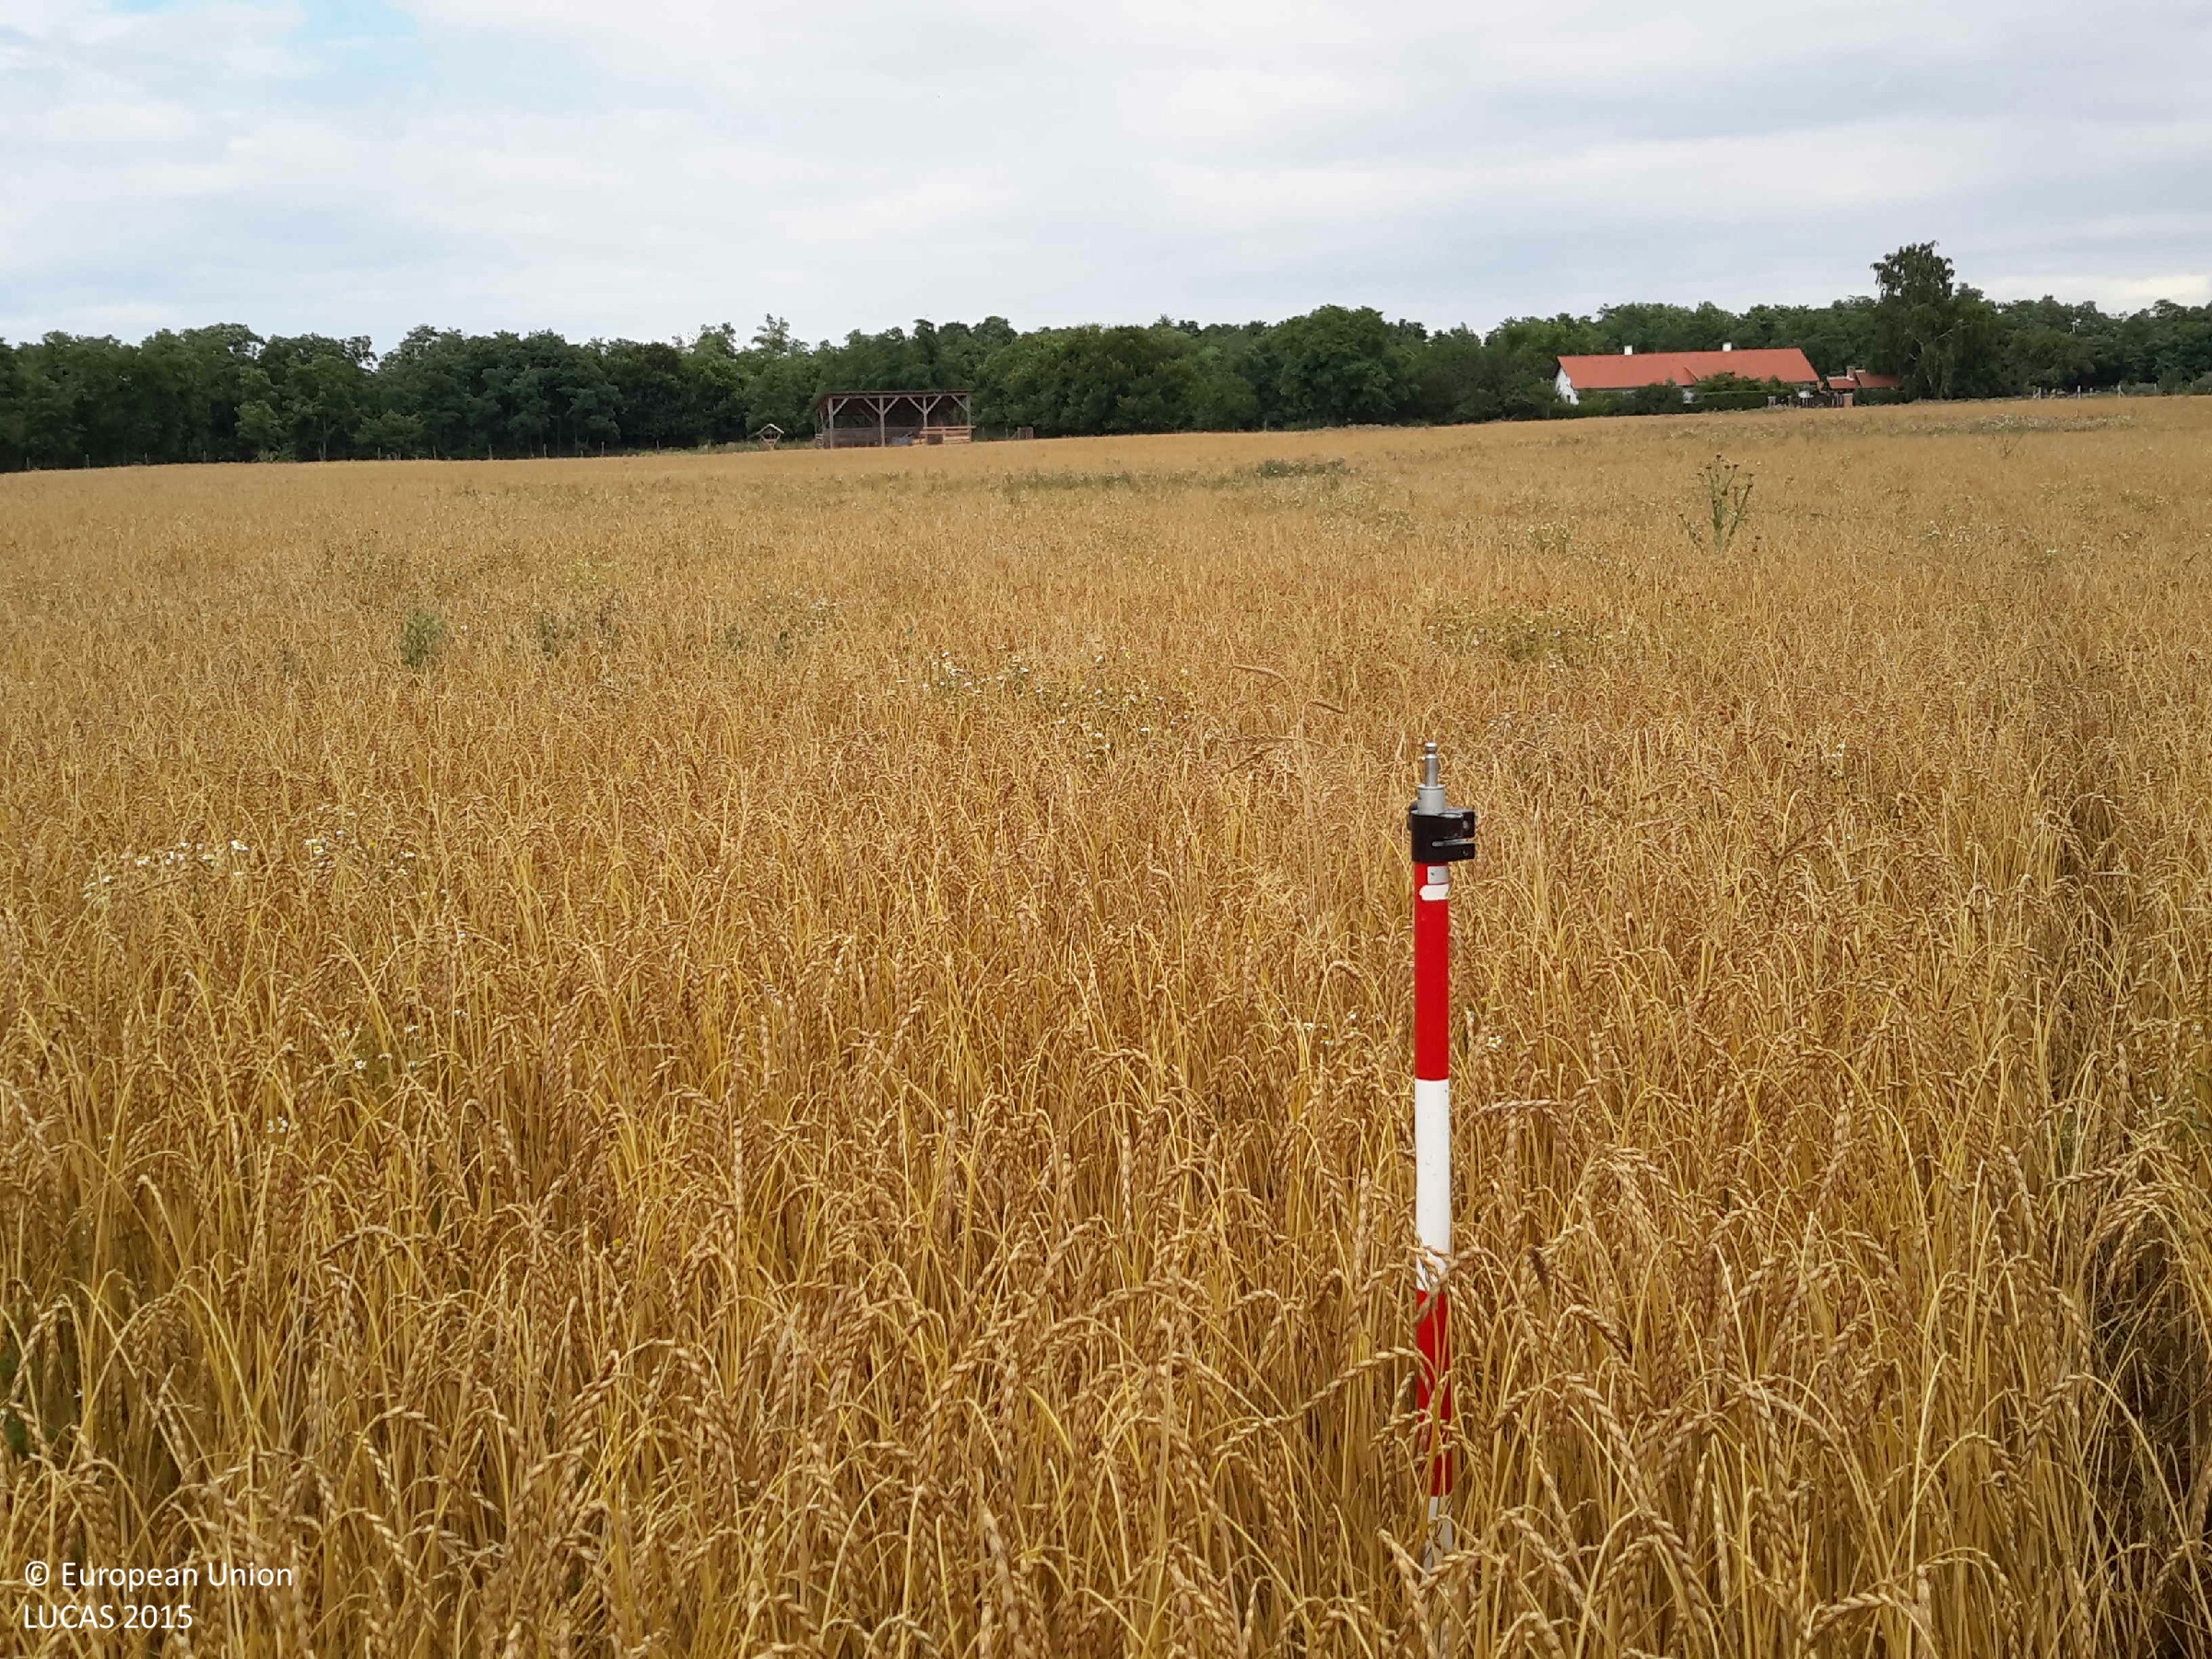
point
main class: Cropland
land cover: Durum wheat
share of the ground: > 75 %
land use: Agriculture (excluding fallow land and kitchen gardens)
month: July
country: HU
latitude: 47.2785
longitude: 16.9984
